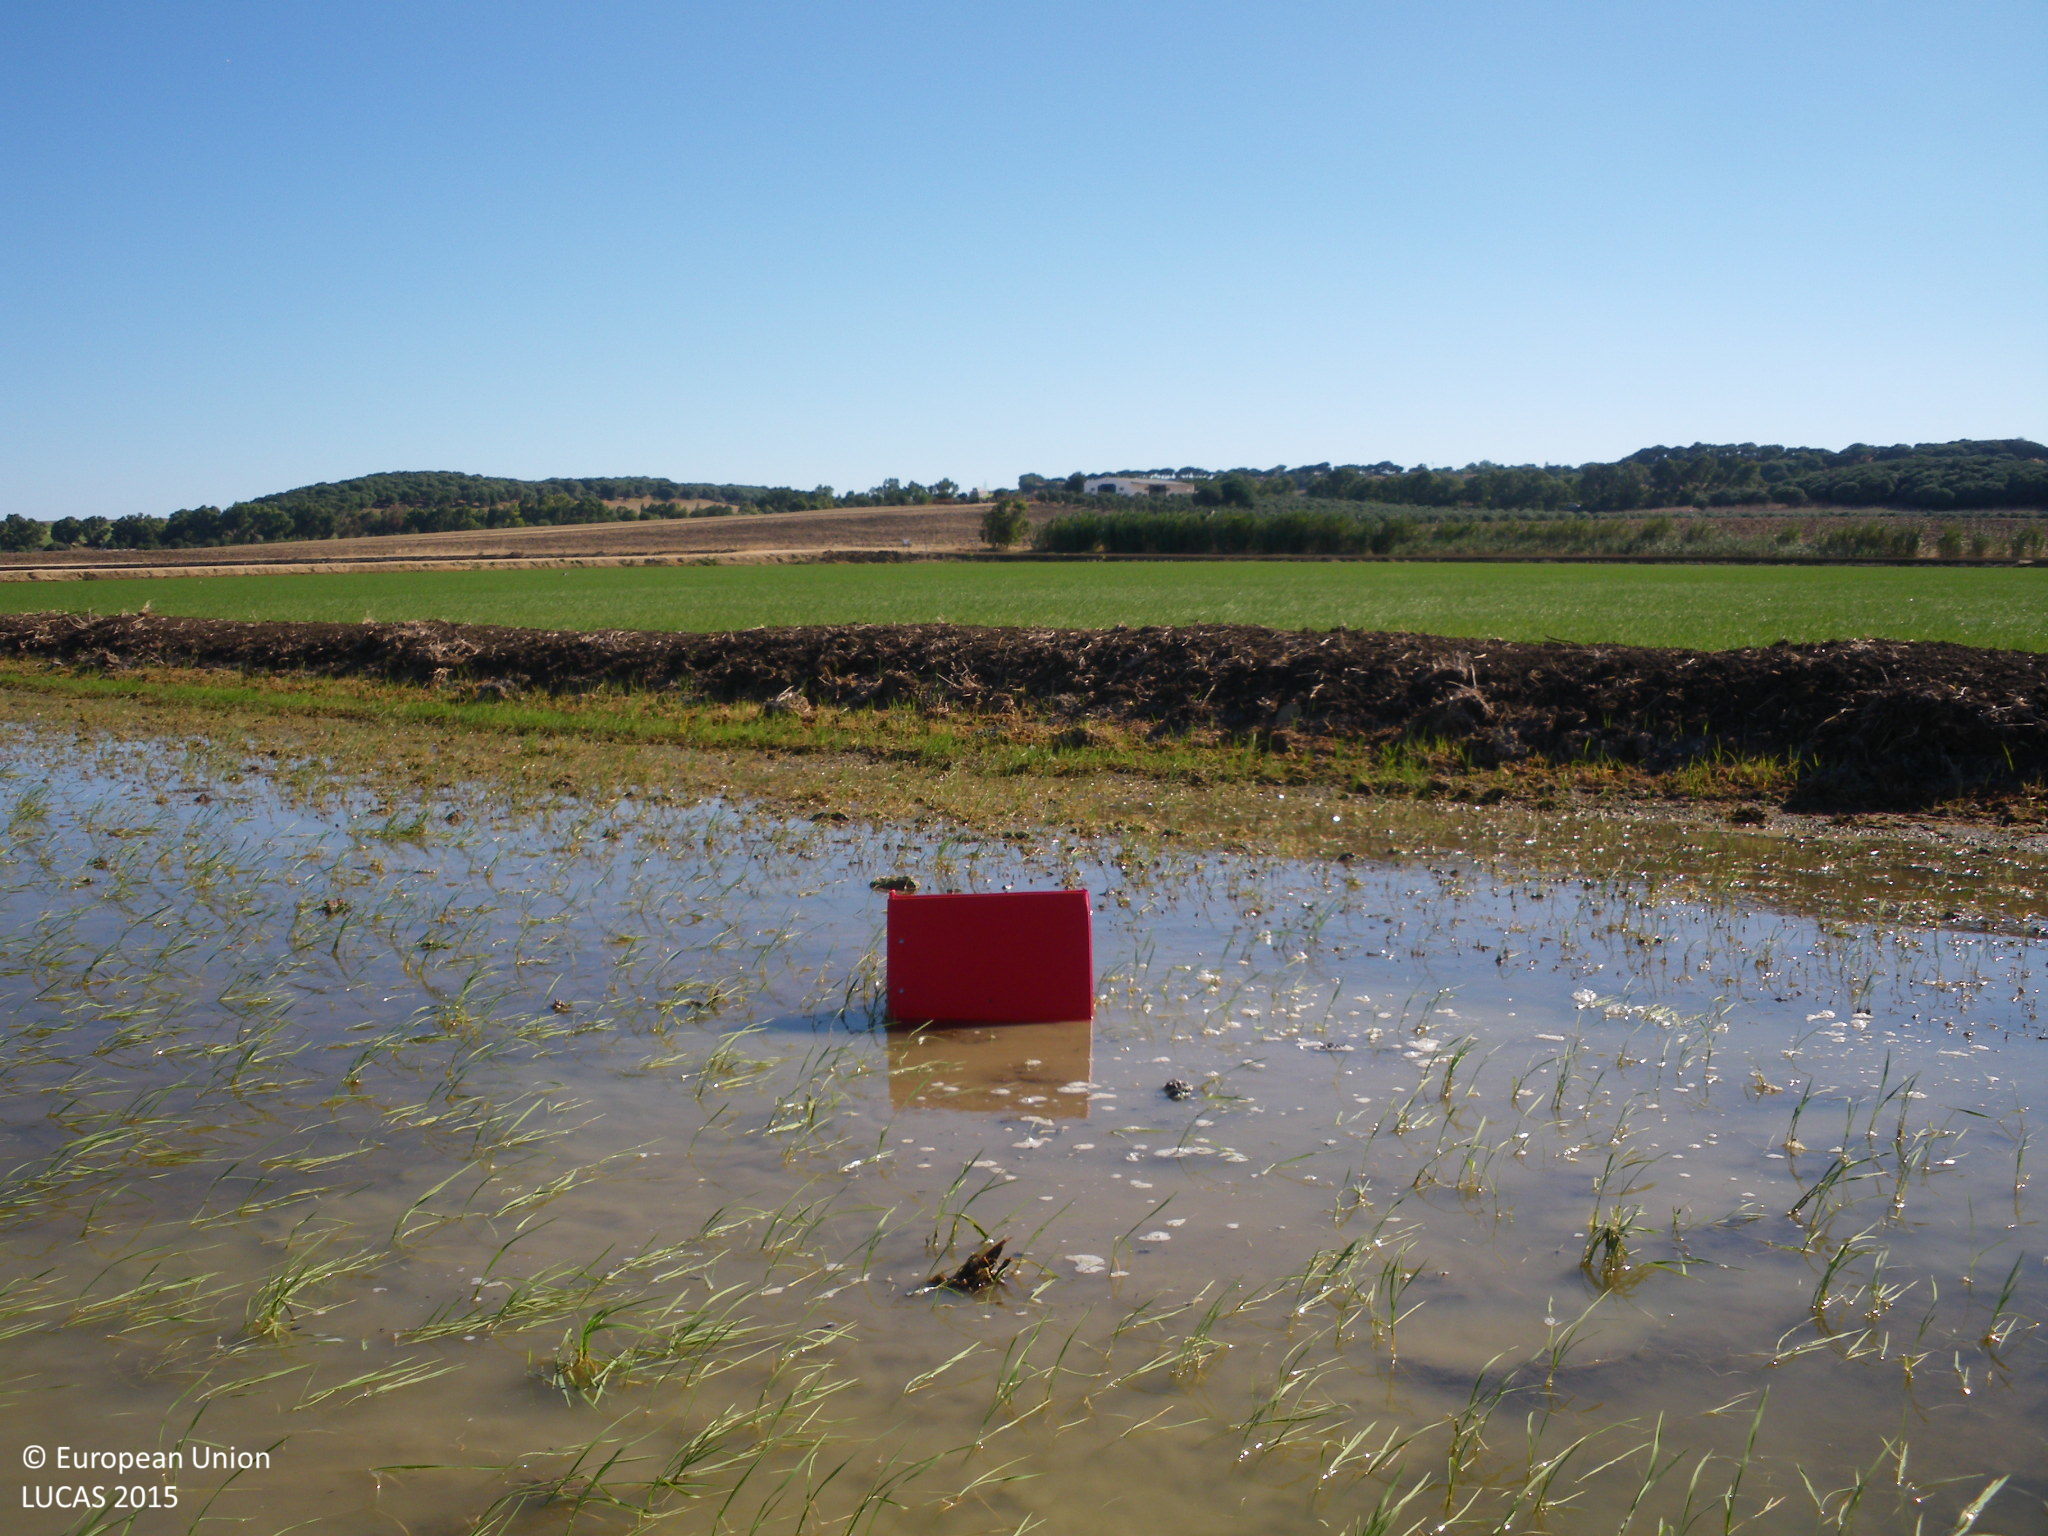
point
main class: Cropland
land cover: Rice
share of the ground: > 75 %
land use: Agriculture (excluding fallow land and kitchen gardens)
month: June
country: ES
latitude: 36.2383
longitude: -5.8775
